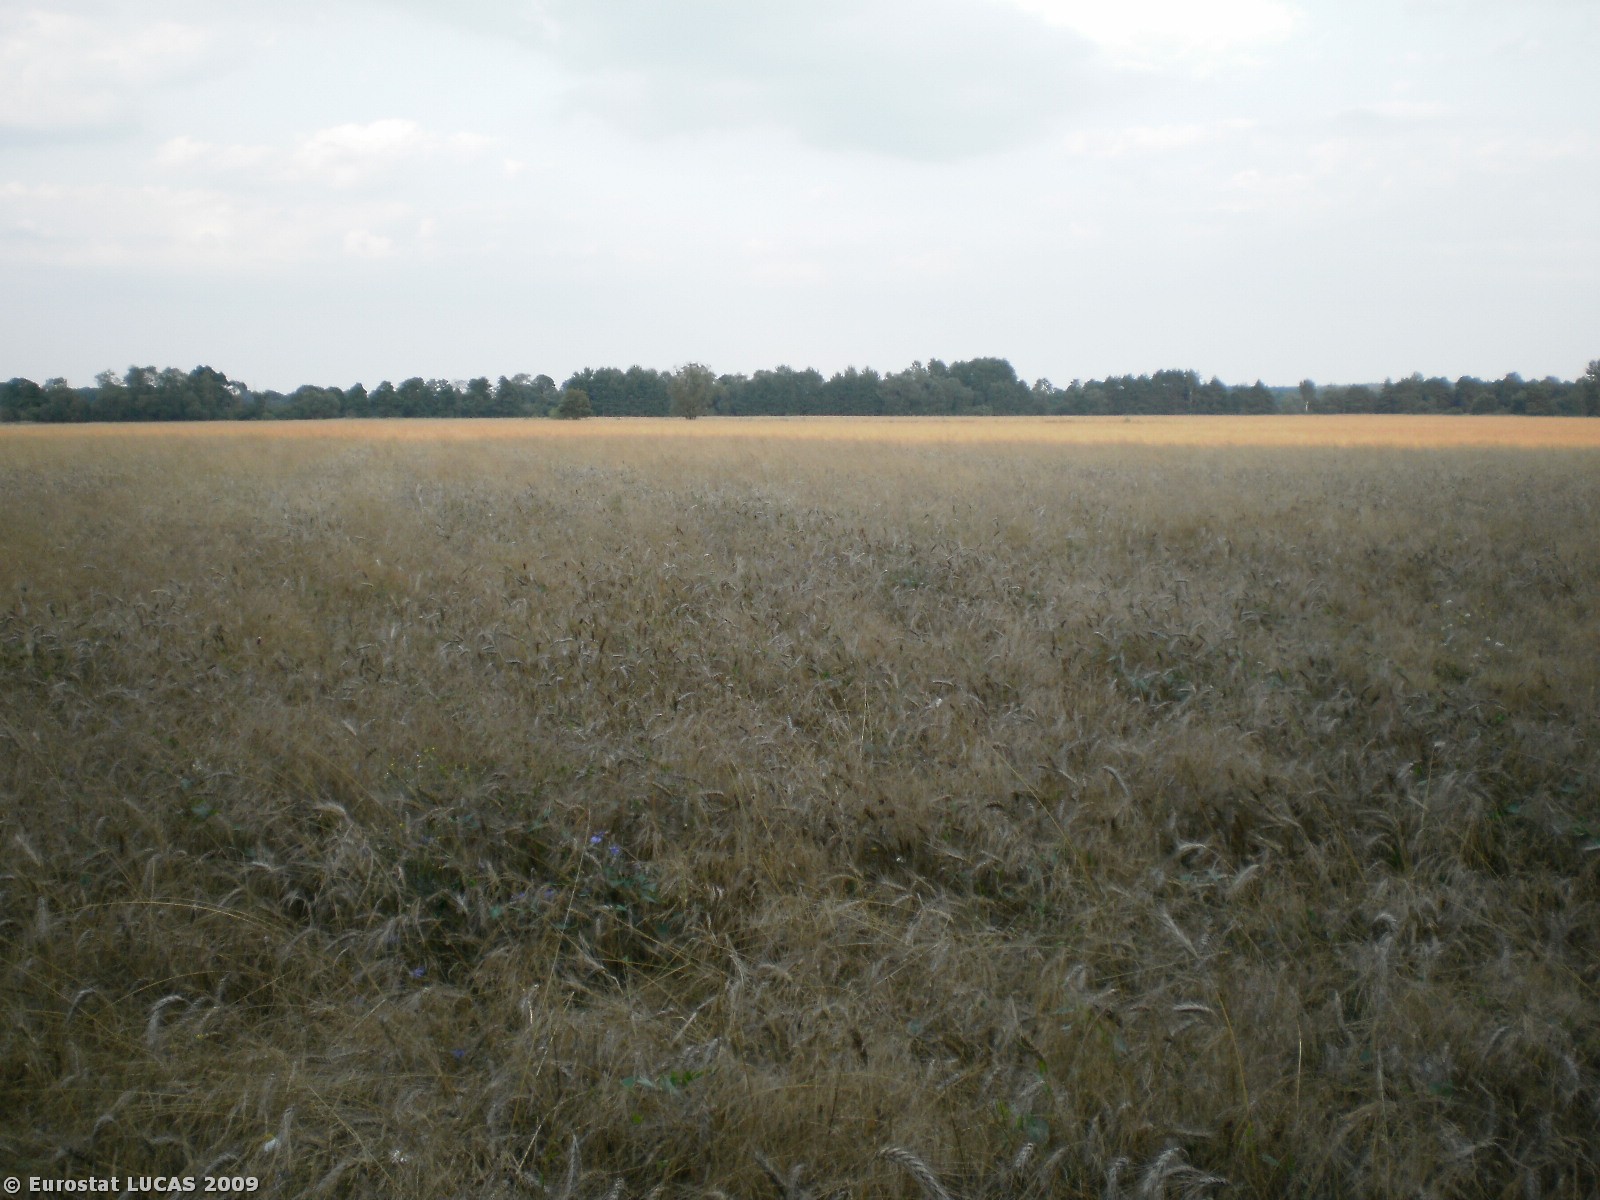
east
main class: Cropland
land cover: Triticale
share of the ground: > 75 %
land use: Agriculture (excluding fallow land and kitchen gardens)
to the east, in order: Triticale; Broadleaved woodland; Inland marshes; Broadleaved woodland; Spontaneously vegetated surfaces
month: July
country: PL
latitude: 53.4065
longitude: 21.0095
